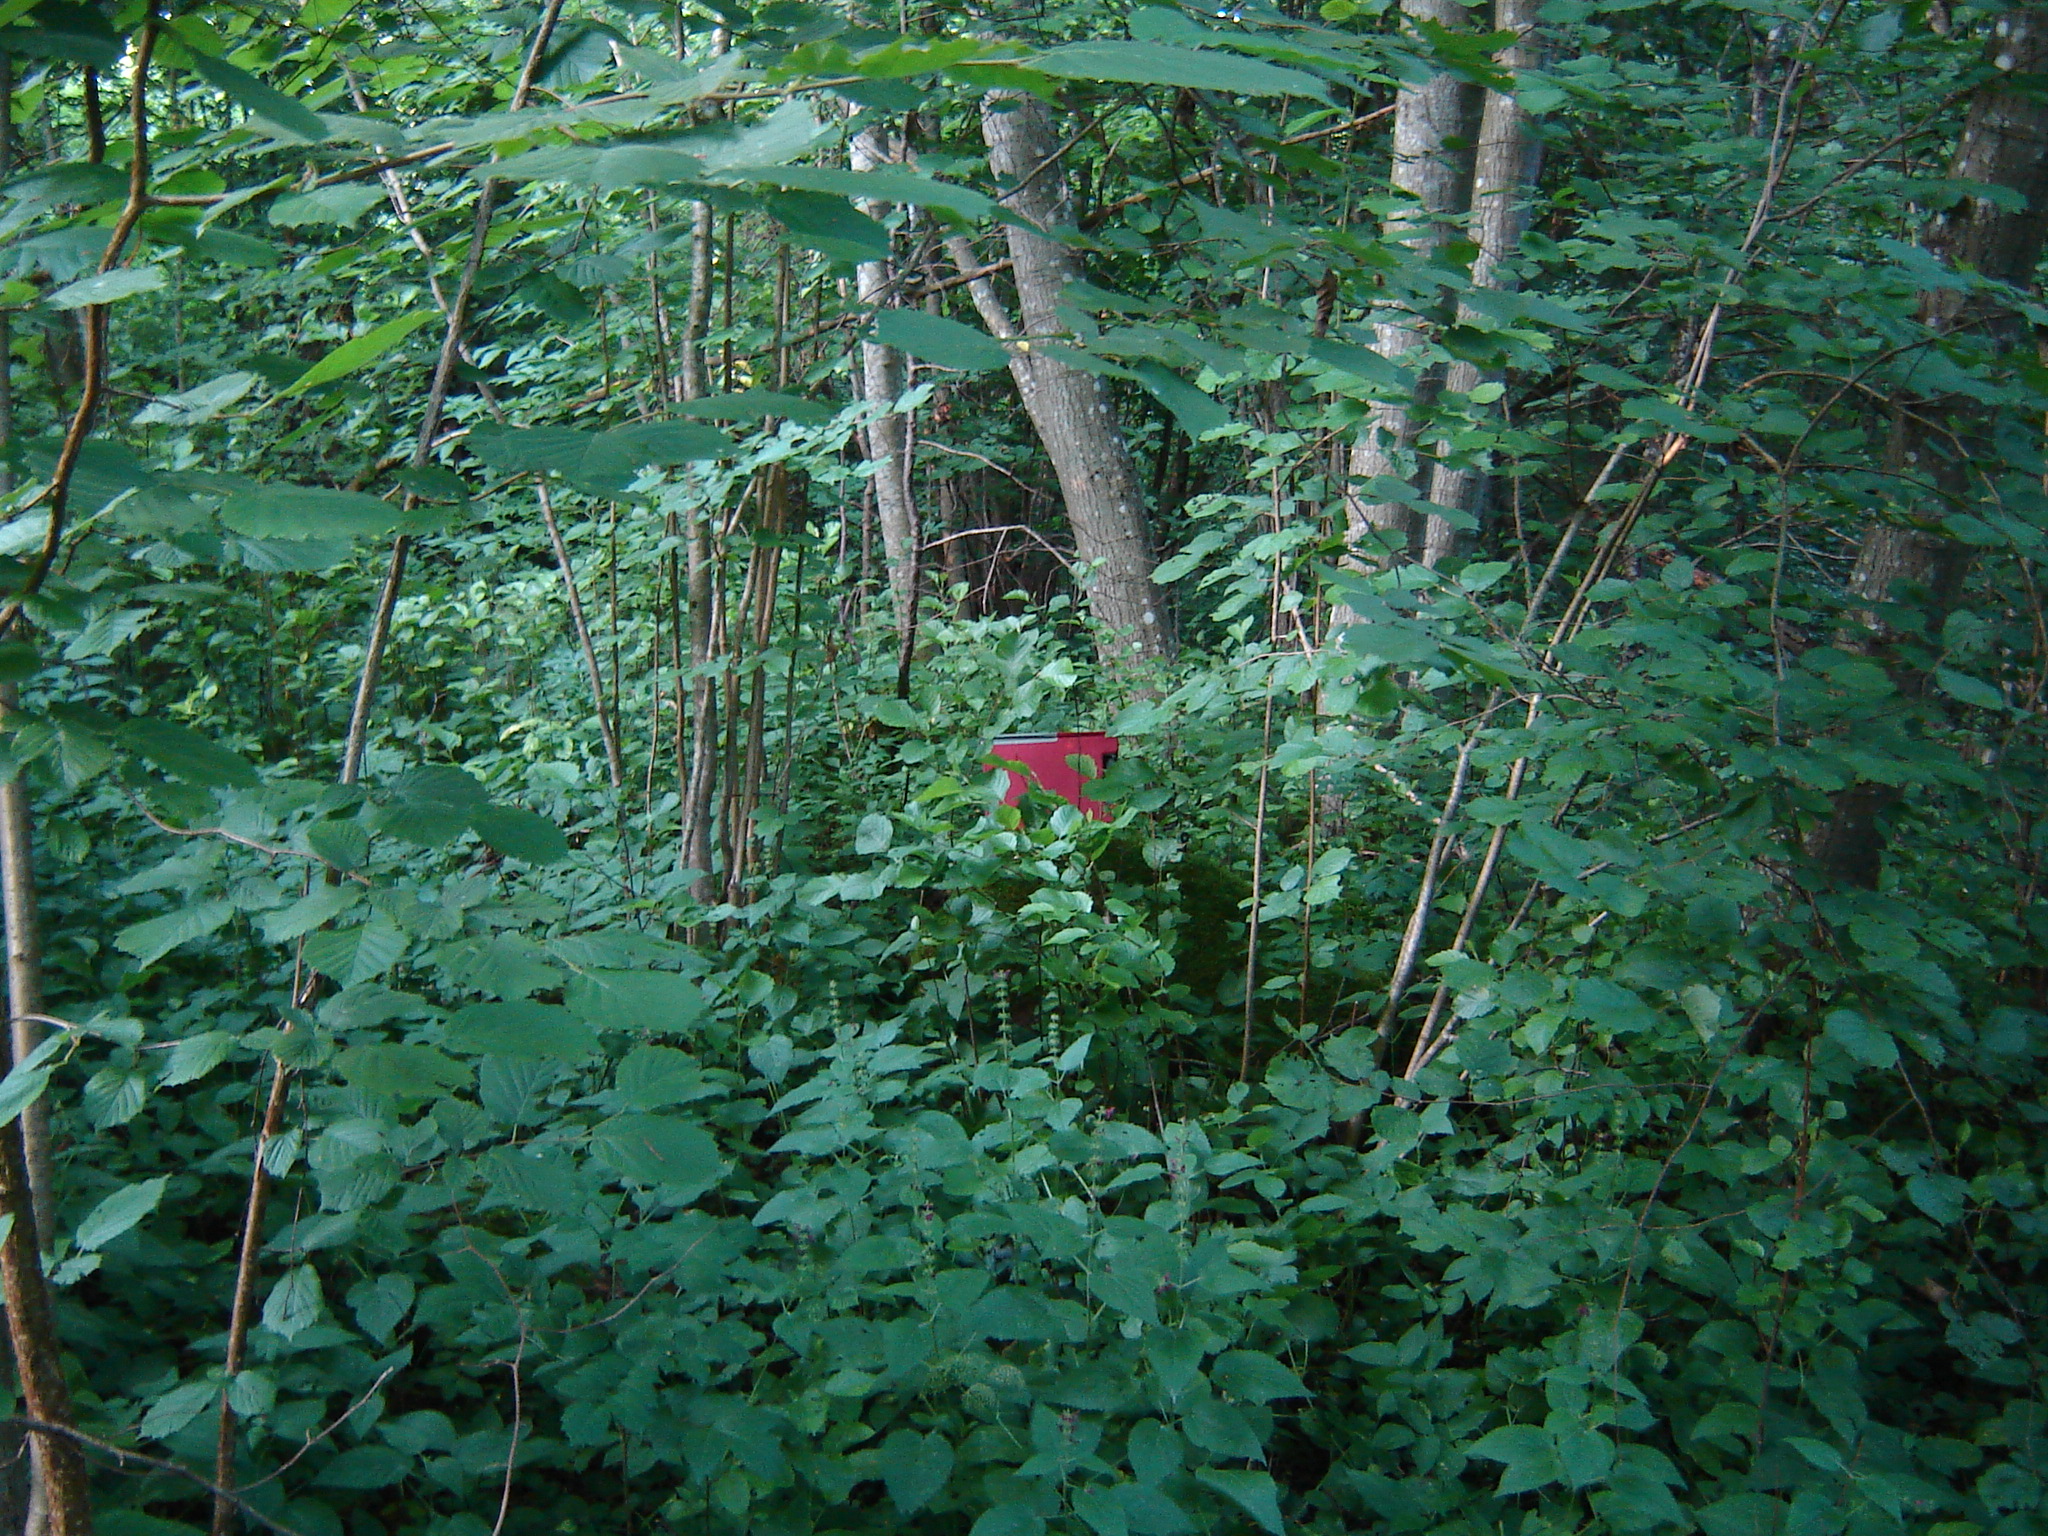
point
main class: Woodland
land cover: Broadleaved woodland
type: non-riverine alder, birch or aspen forest
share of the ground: > 75 %
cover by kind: broadleaved forest trees 100 %
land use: Forestry
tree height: > 5 m
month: July
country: LT
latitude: 55.3999
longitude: 25.5211
